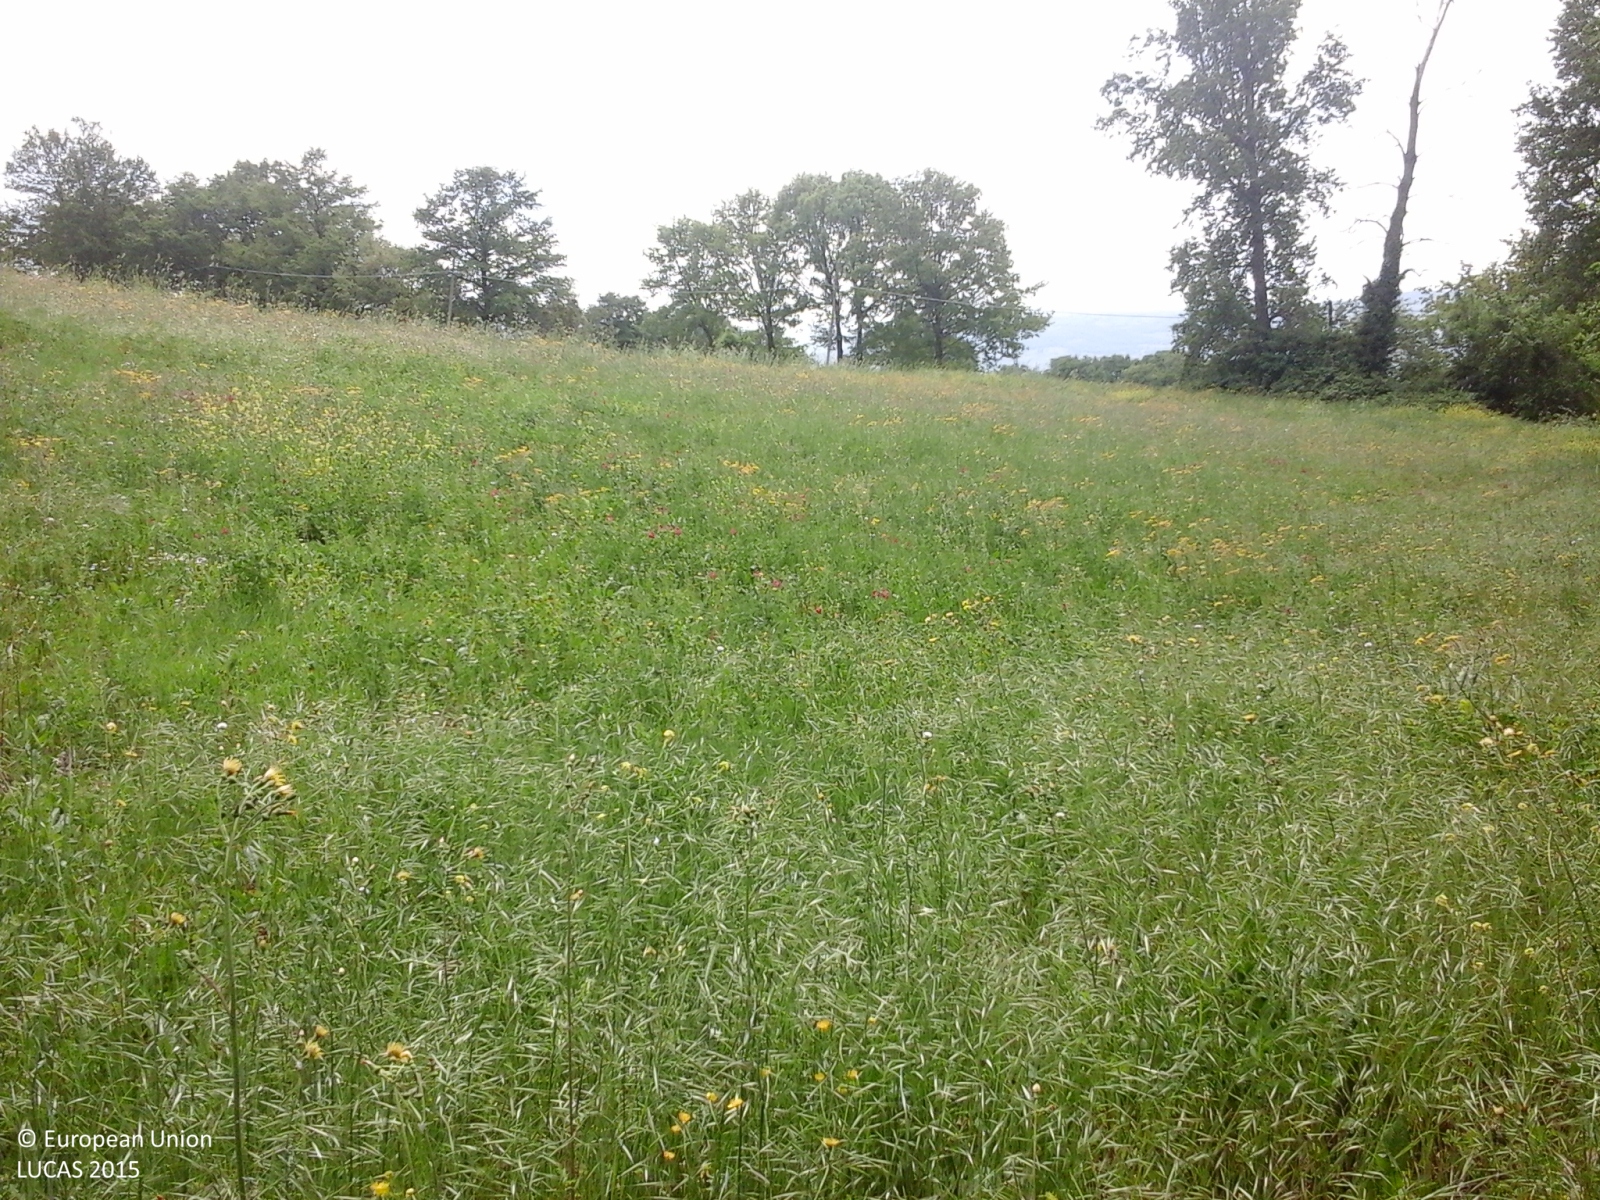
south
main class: Woodland
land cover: Broadleaved woodland
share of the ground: > 75 %
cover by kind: broadleaved forest trees 80 %, shrubs 20 %
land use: Forestry
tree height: > 5 m
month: May
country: IT
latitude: 41.3864
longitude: 14.7067
